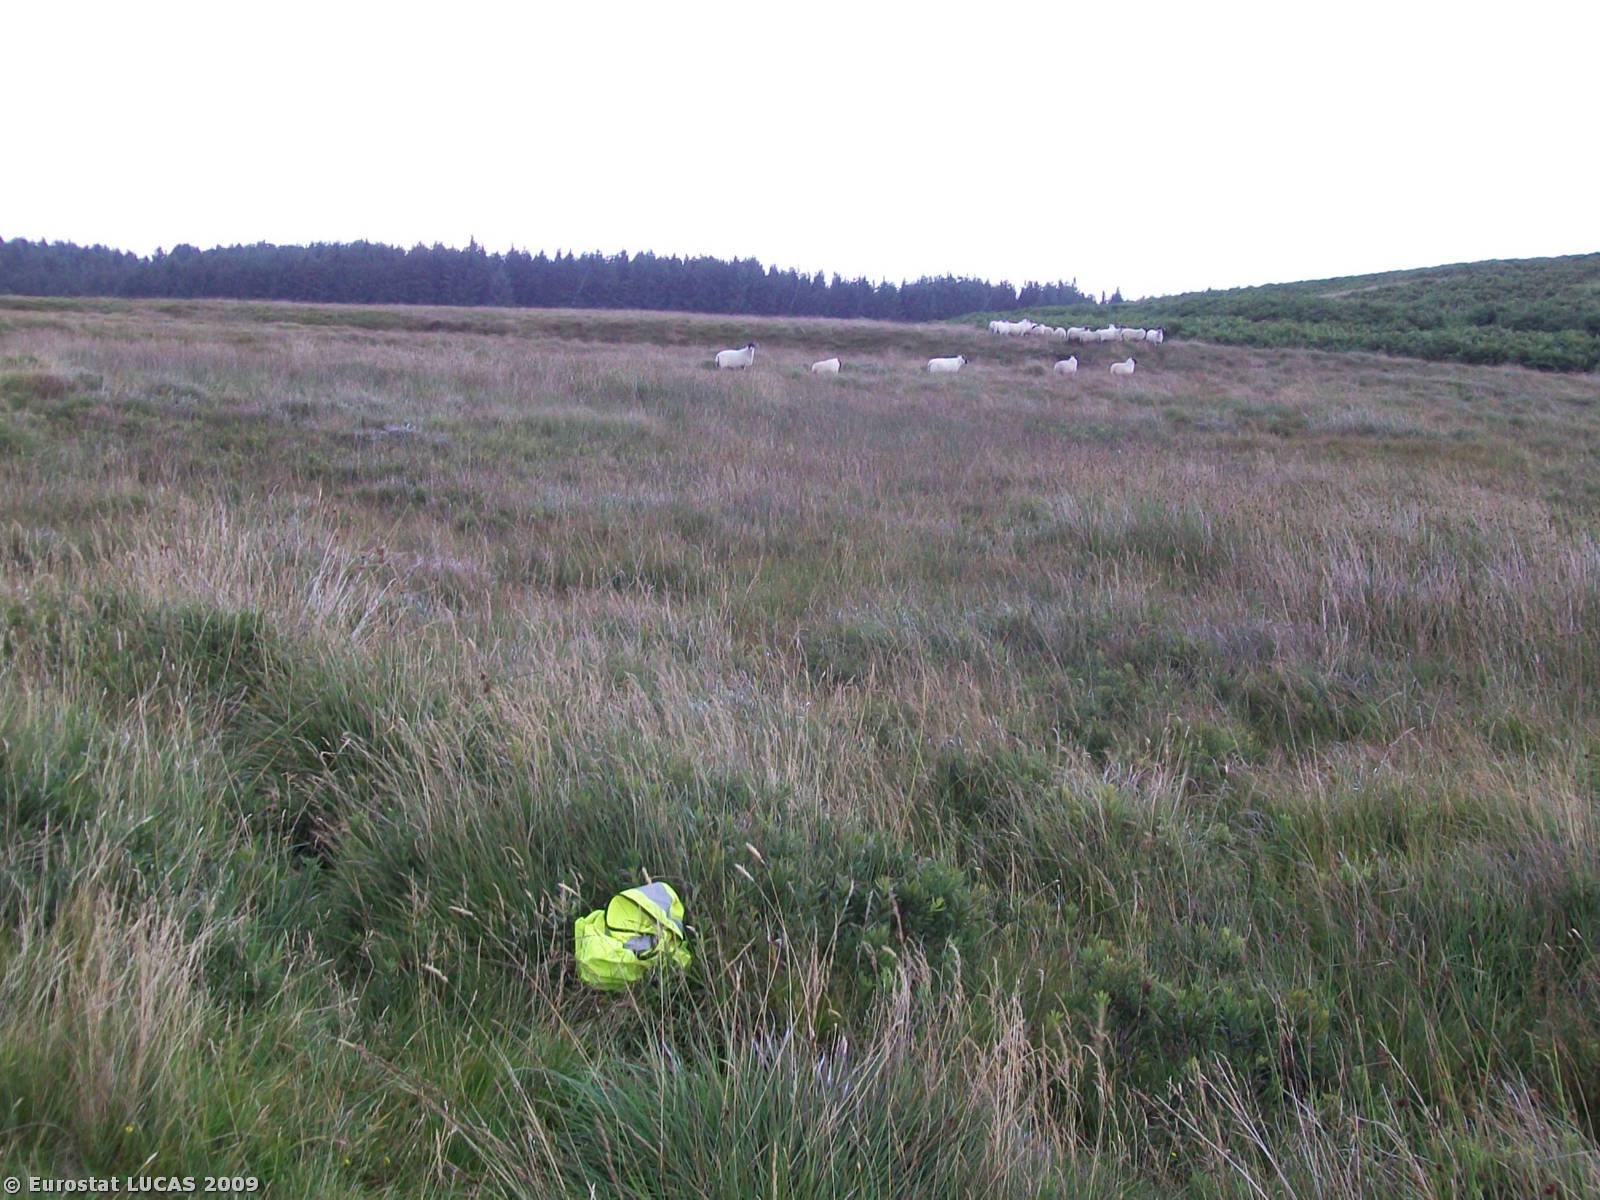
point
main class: Grassland
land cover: Grassland without tree/shrub cover
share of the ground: > 75 %
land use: Agriculture (excluding fallow land and kitchen gardens)
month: August
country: GB
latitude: 54.9070
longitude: -4.7533
